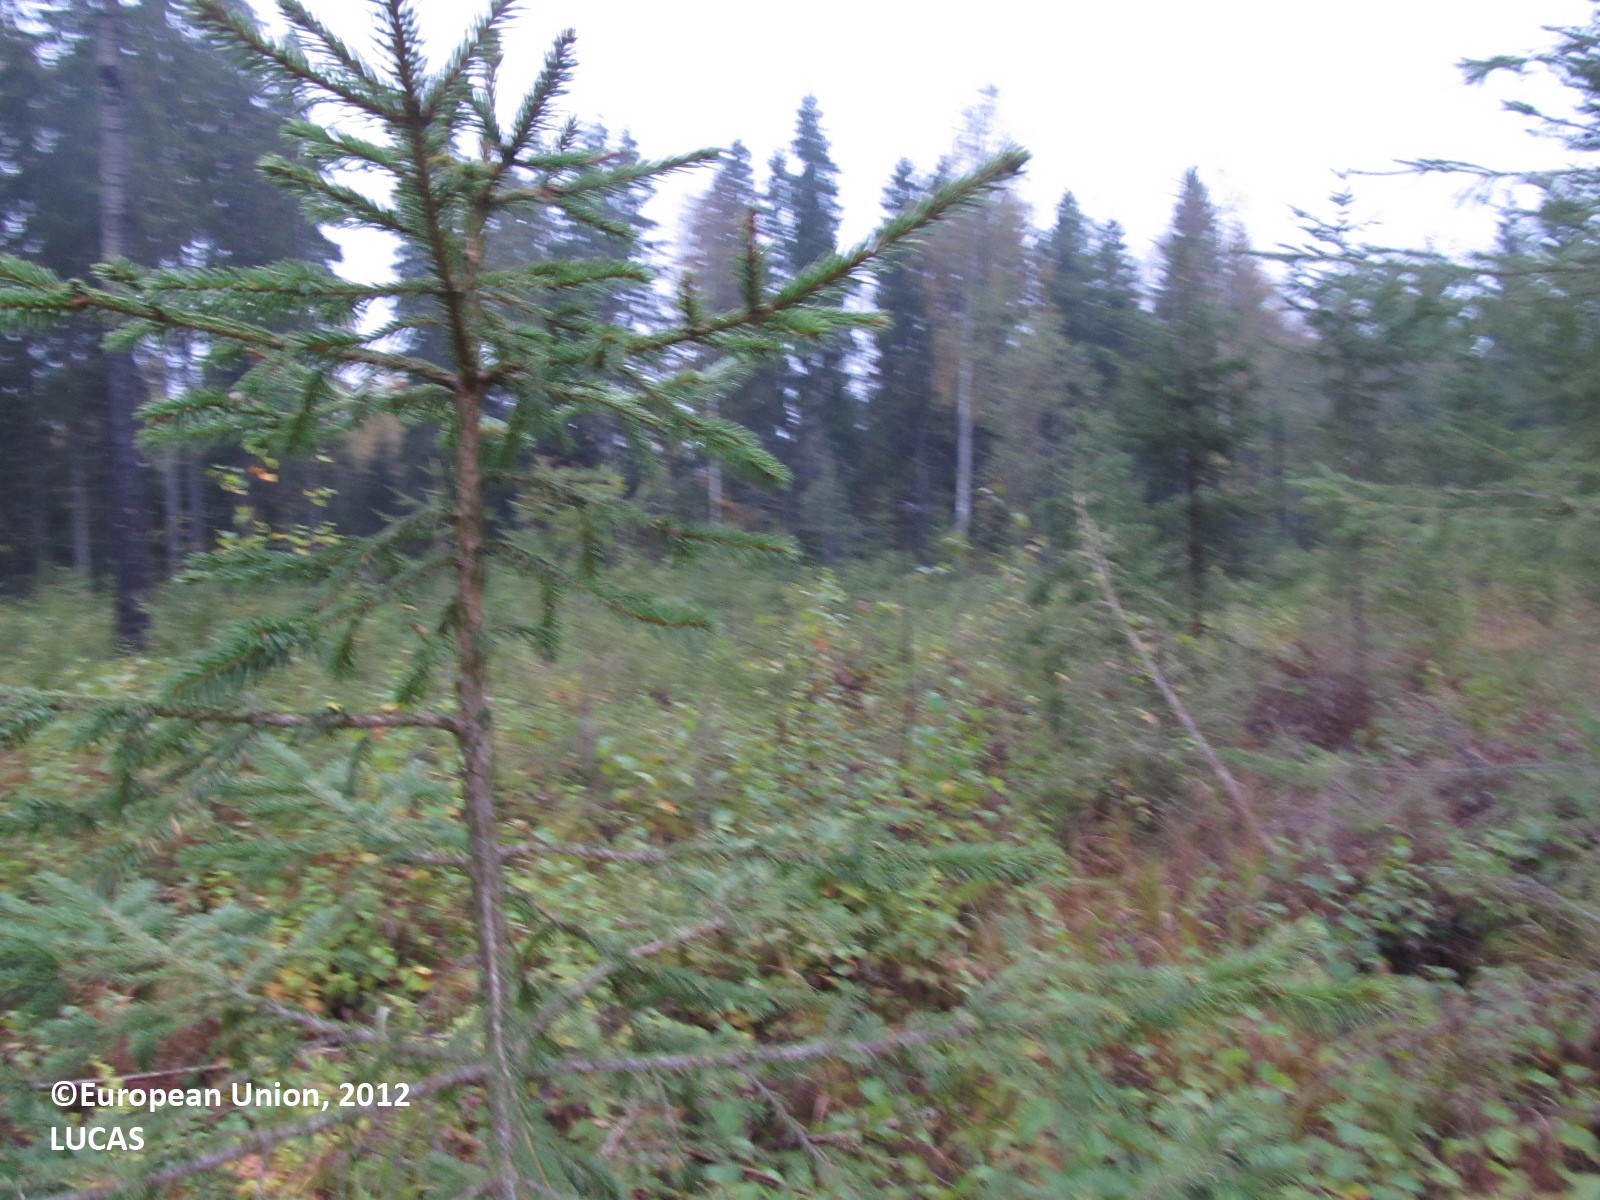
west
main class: Woodland
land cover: Spruce dominated mixed woodland
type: boreal forest
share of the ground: 50 - 75 %
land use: Forestry
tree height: < 5 m
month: September
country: FI
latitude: 62.2855
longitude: 28.2149
